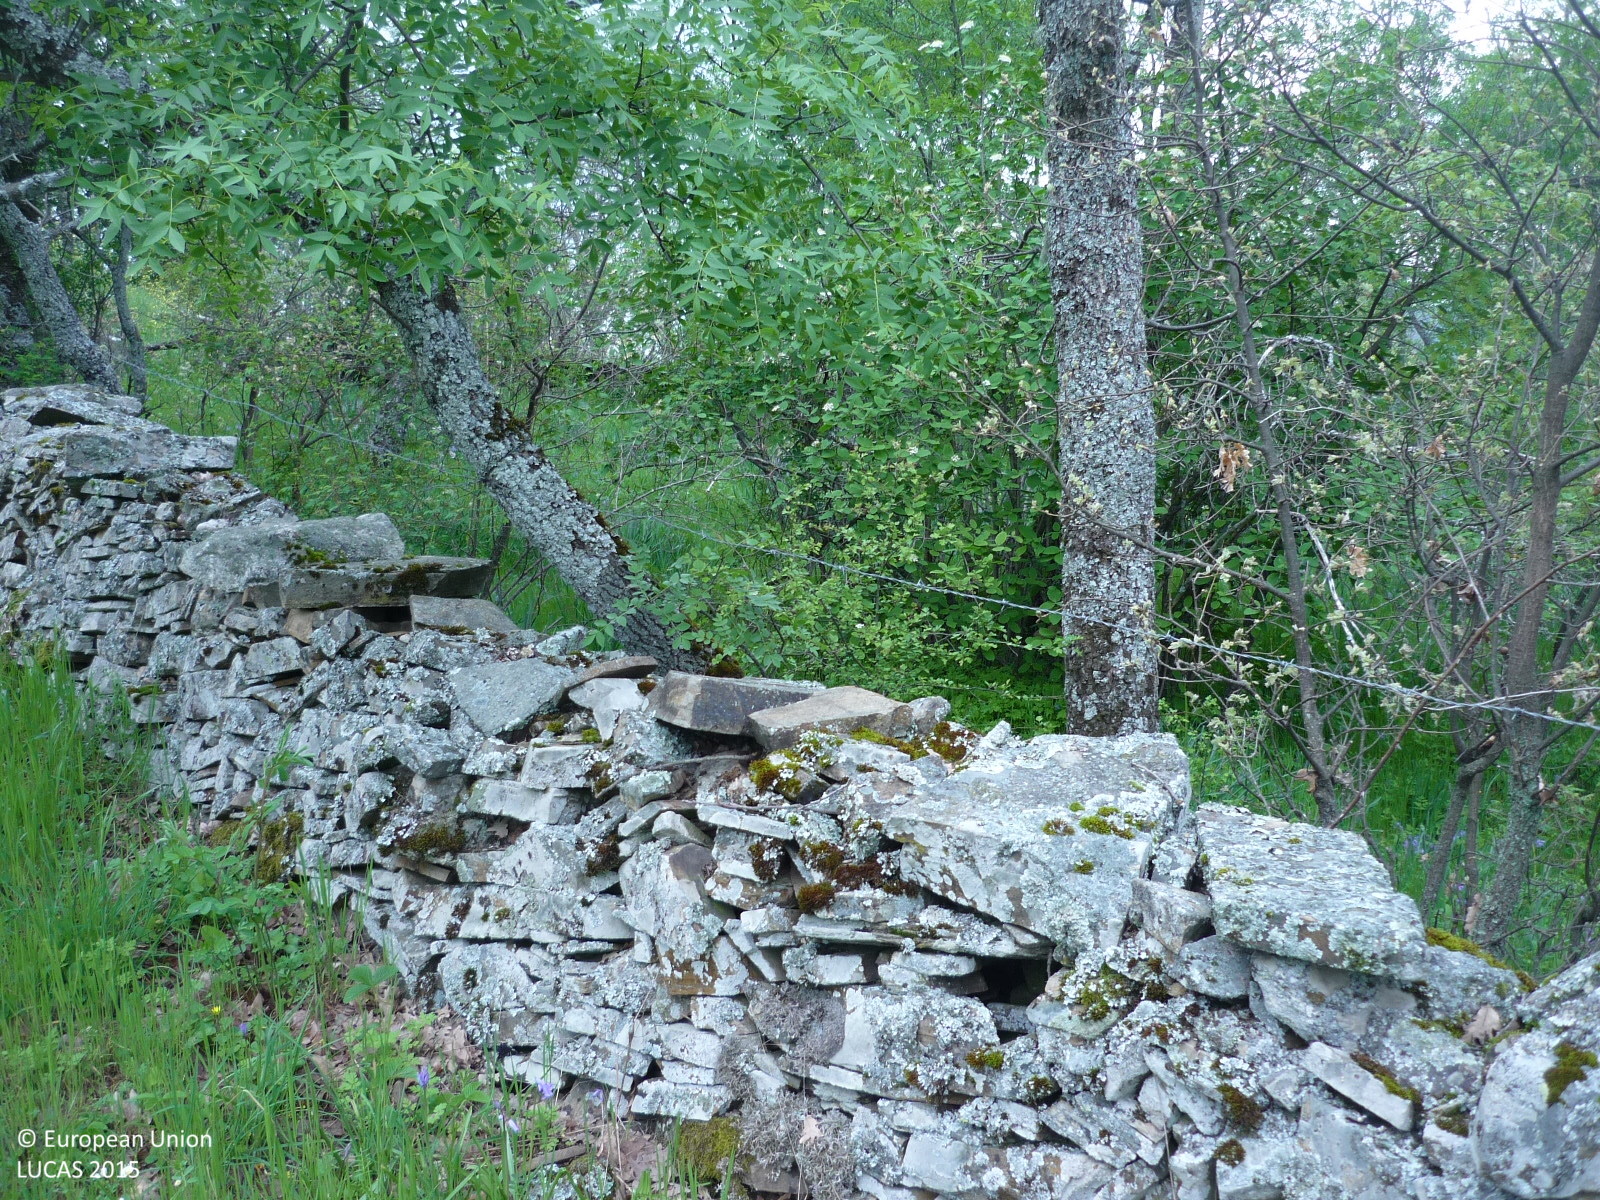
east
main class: Grassland
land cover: Grassland without tree/shrub cover
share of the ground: > 75 %
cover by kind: herbaceous plants 100 %
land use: Agriculture (excluding fallow land and kitchen gardens)
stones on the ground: < 10 %
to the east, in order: Grassland without tree/shrub cover; Dry stone walls; Abandoned hedges; Tracks; Abandoned hedges; Dry stone walls; Broadleaved woodland; Dry stone walls; Grassland with sparse tree/shrub cover; Dry stone walls; Broadleaved woodland; Dry stone walls; Broadleaved woodland
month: May
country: ES
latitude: 41.0652
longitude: -3.5262
